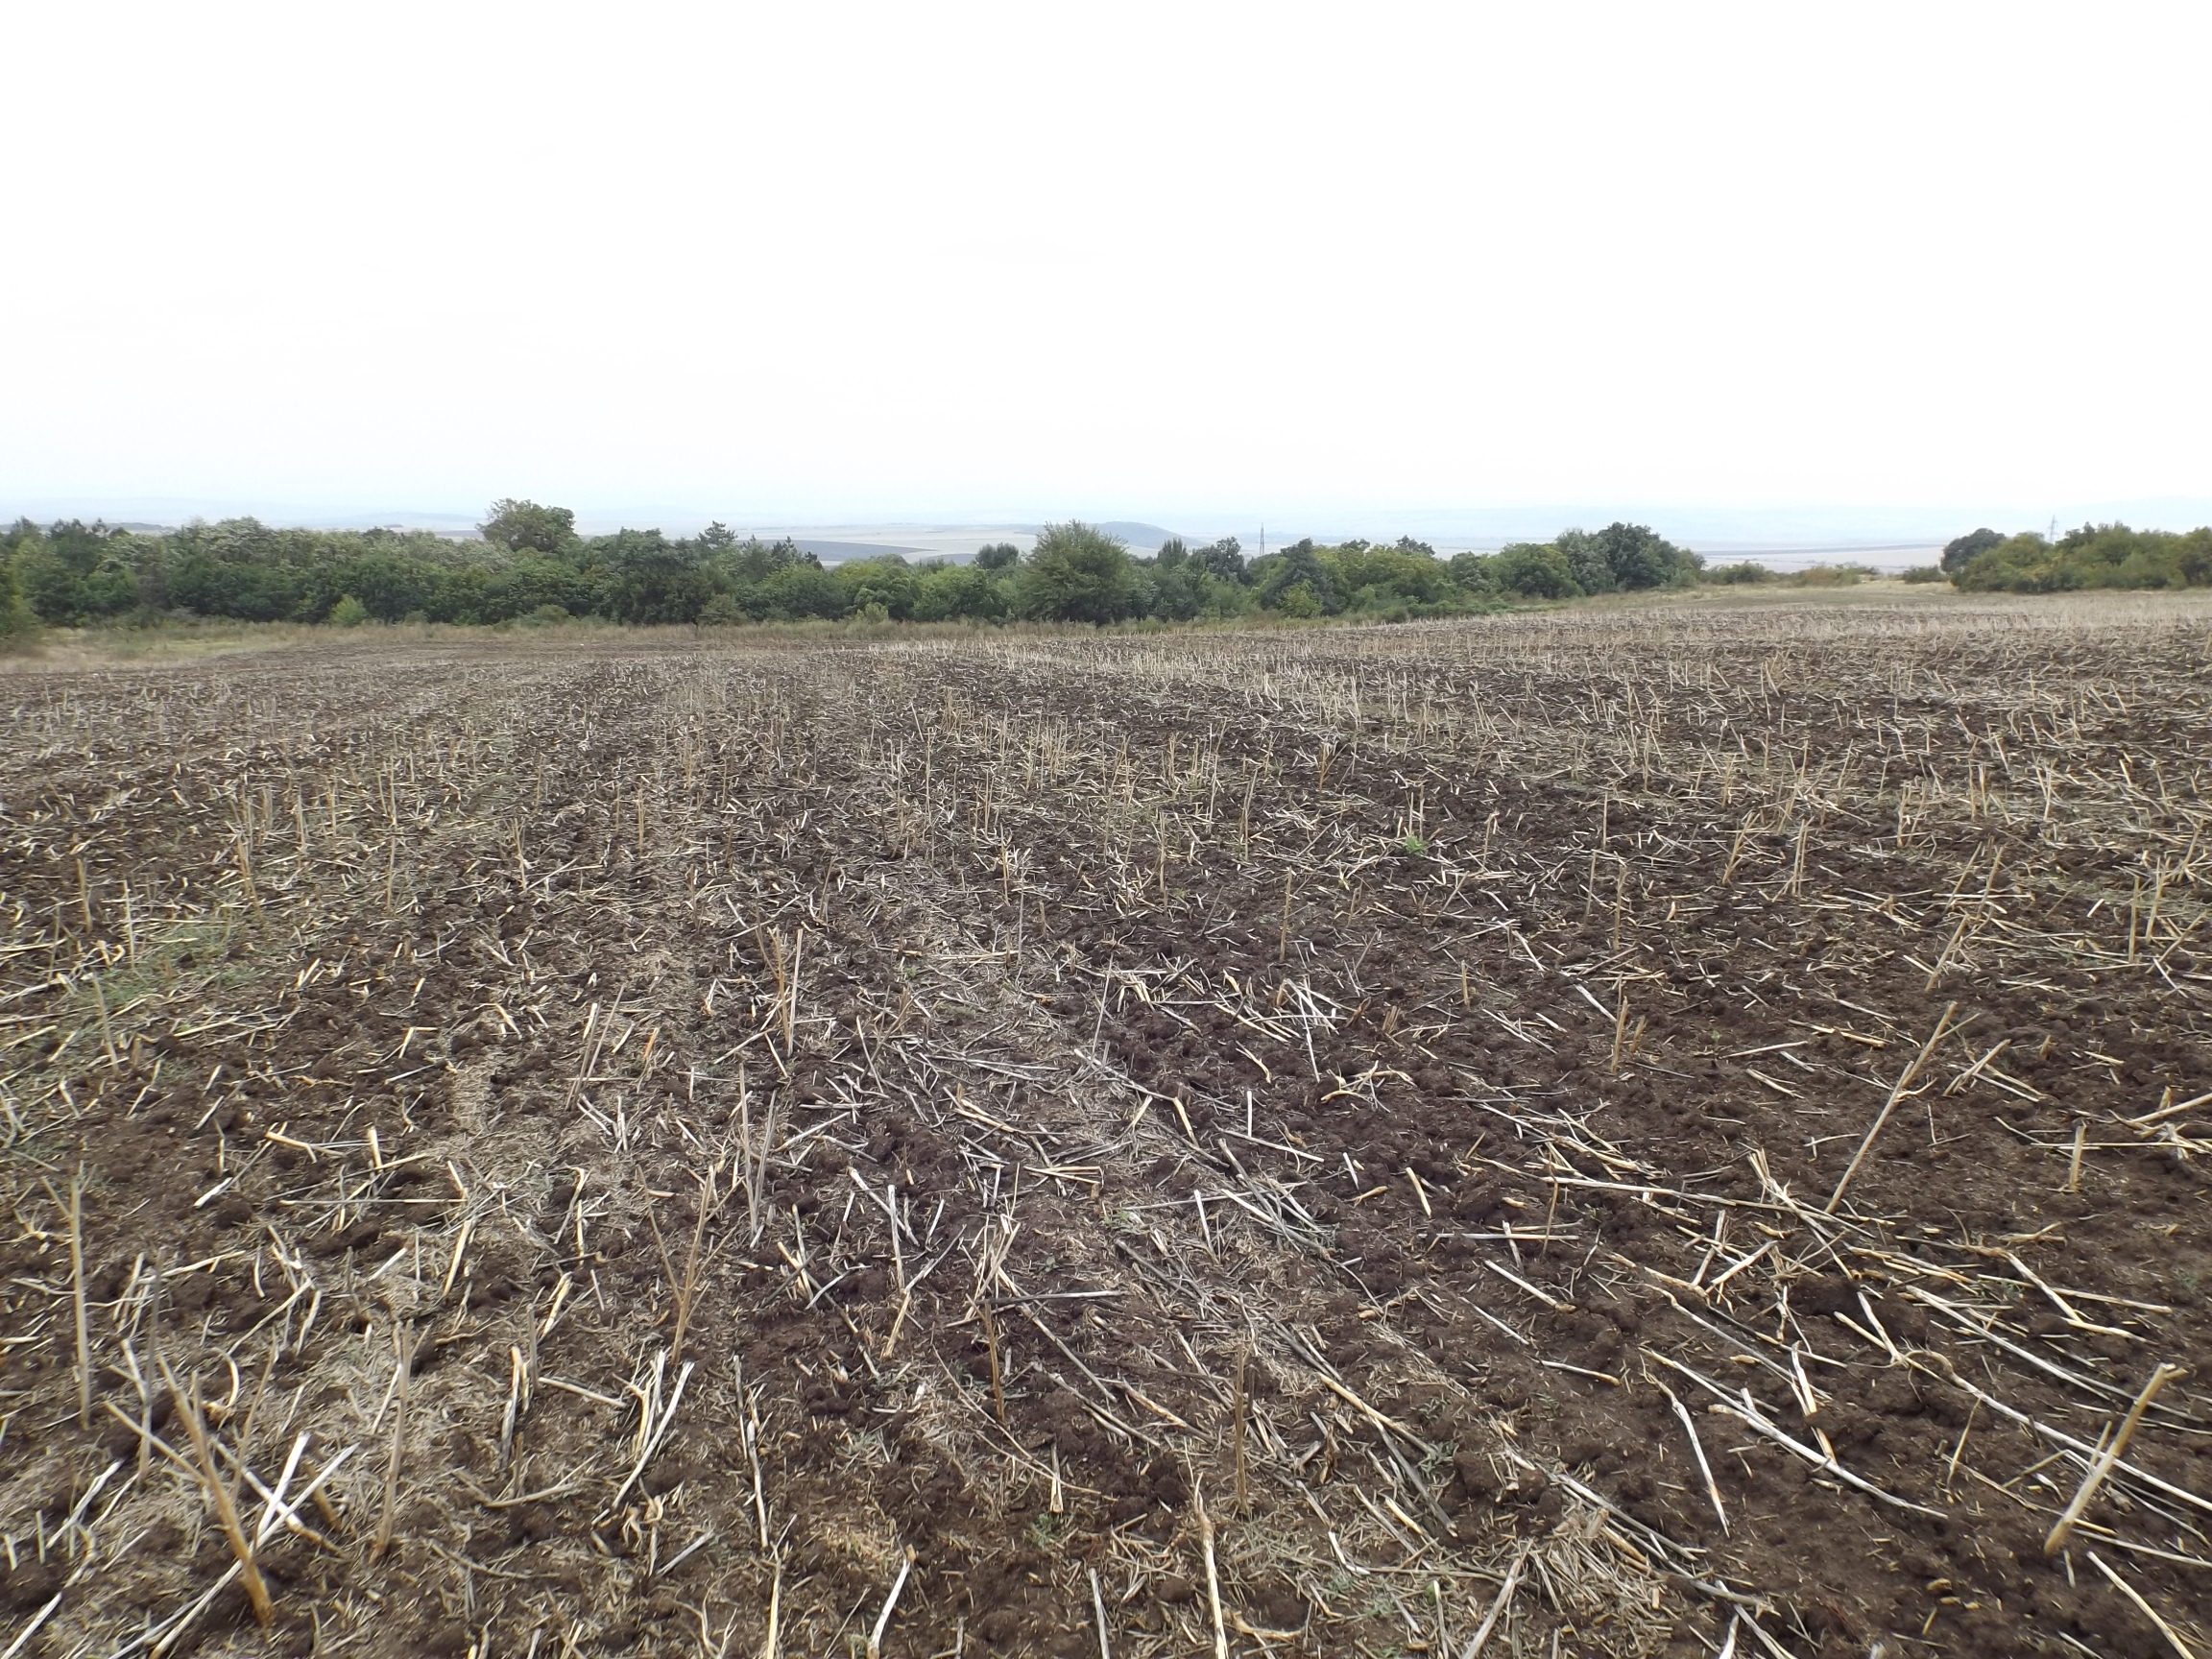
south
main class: Cropland
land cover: Maize
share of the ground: < 10 %
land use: Agriculture (excluding fallow land and kitchen gardens)
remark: Harvested field
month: August
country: BG
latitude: 43.1923
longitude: 27.5400
